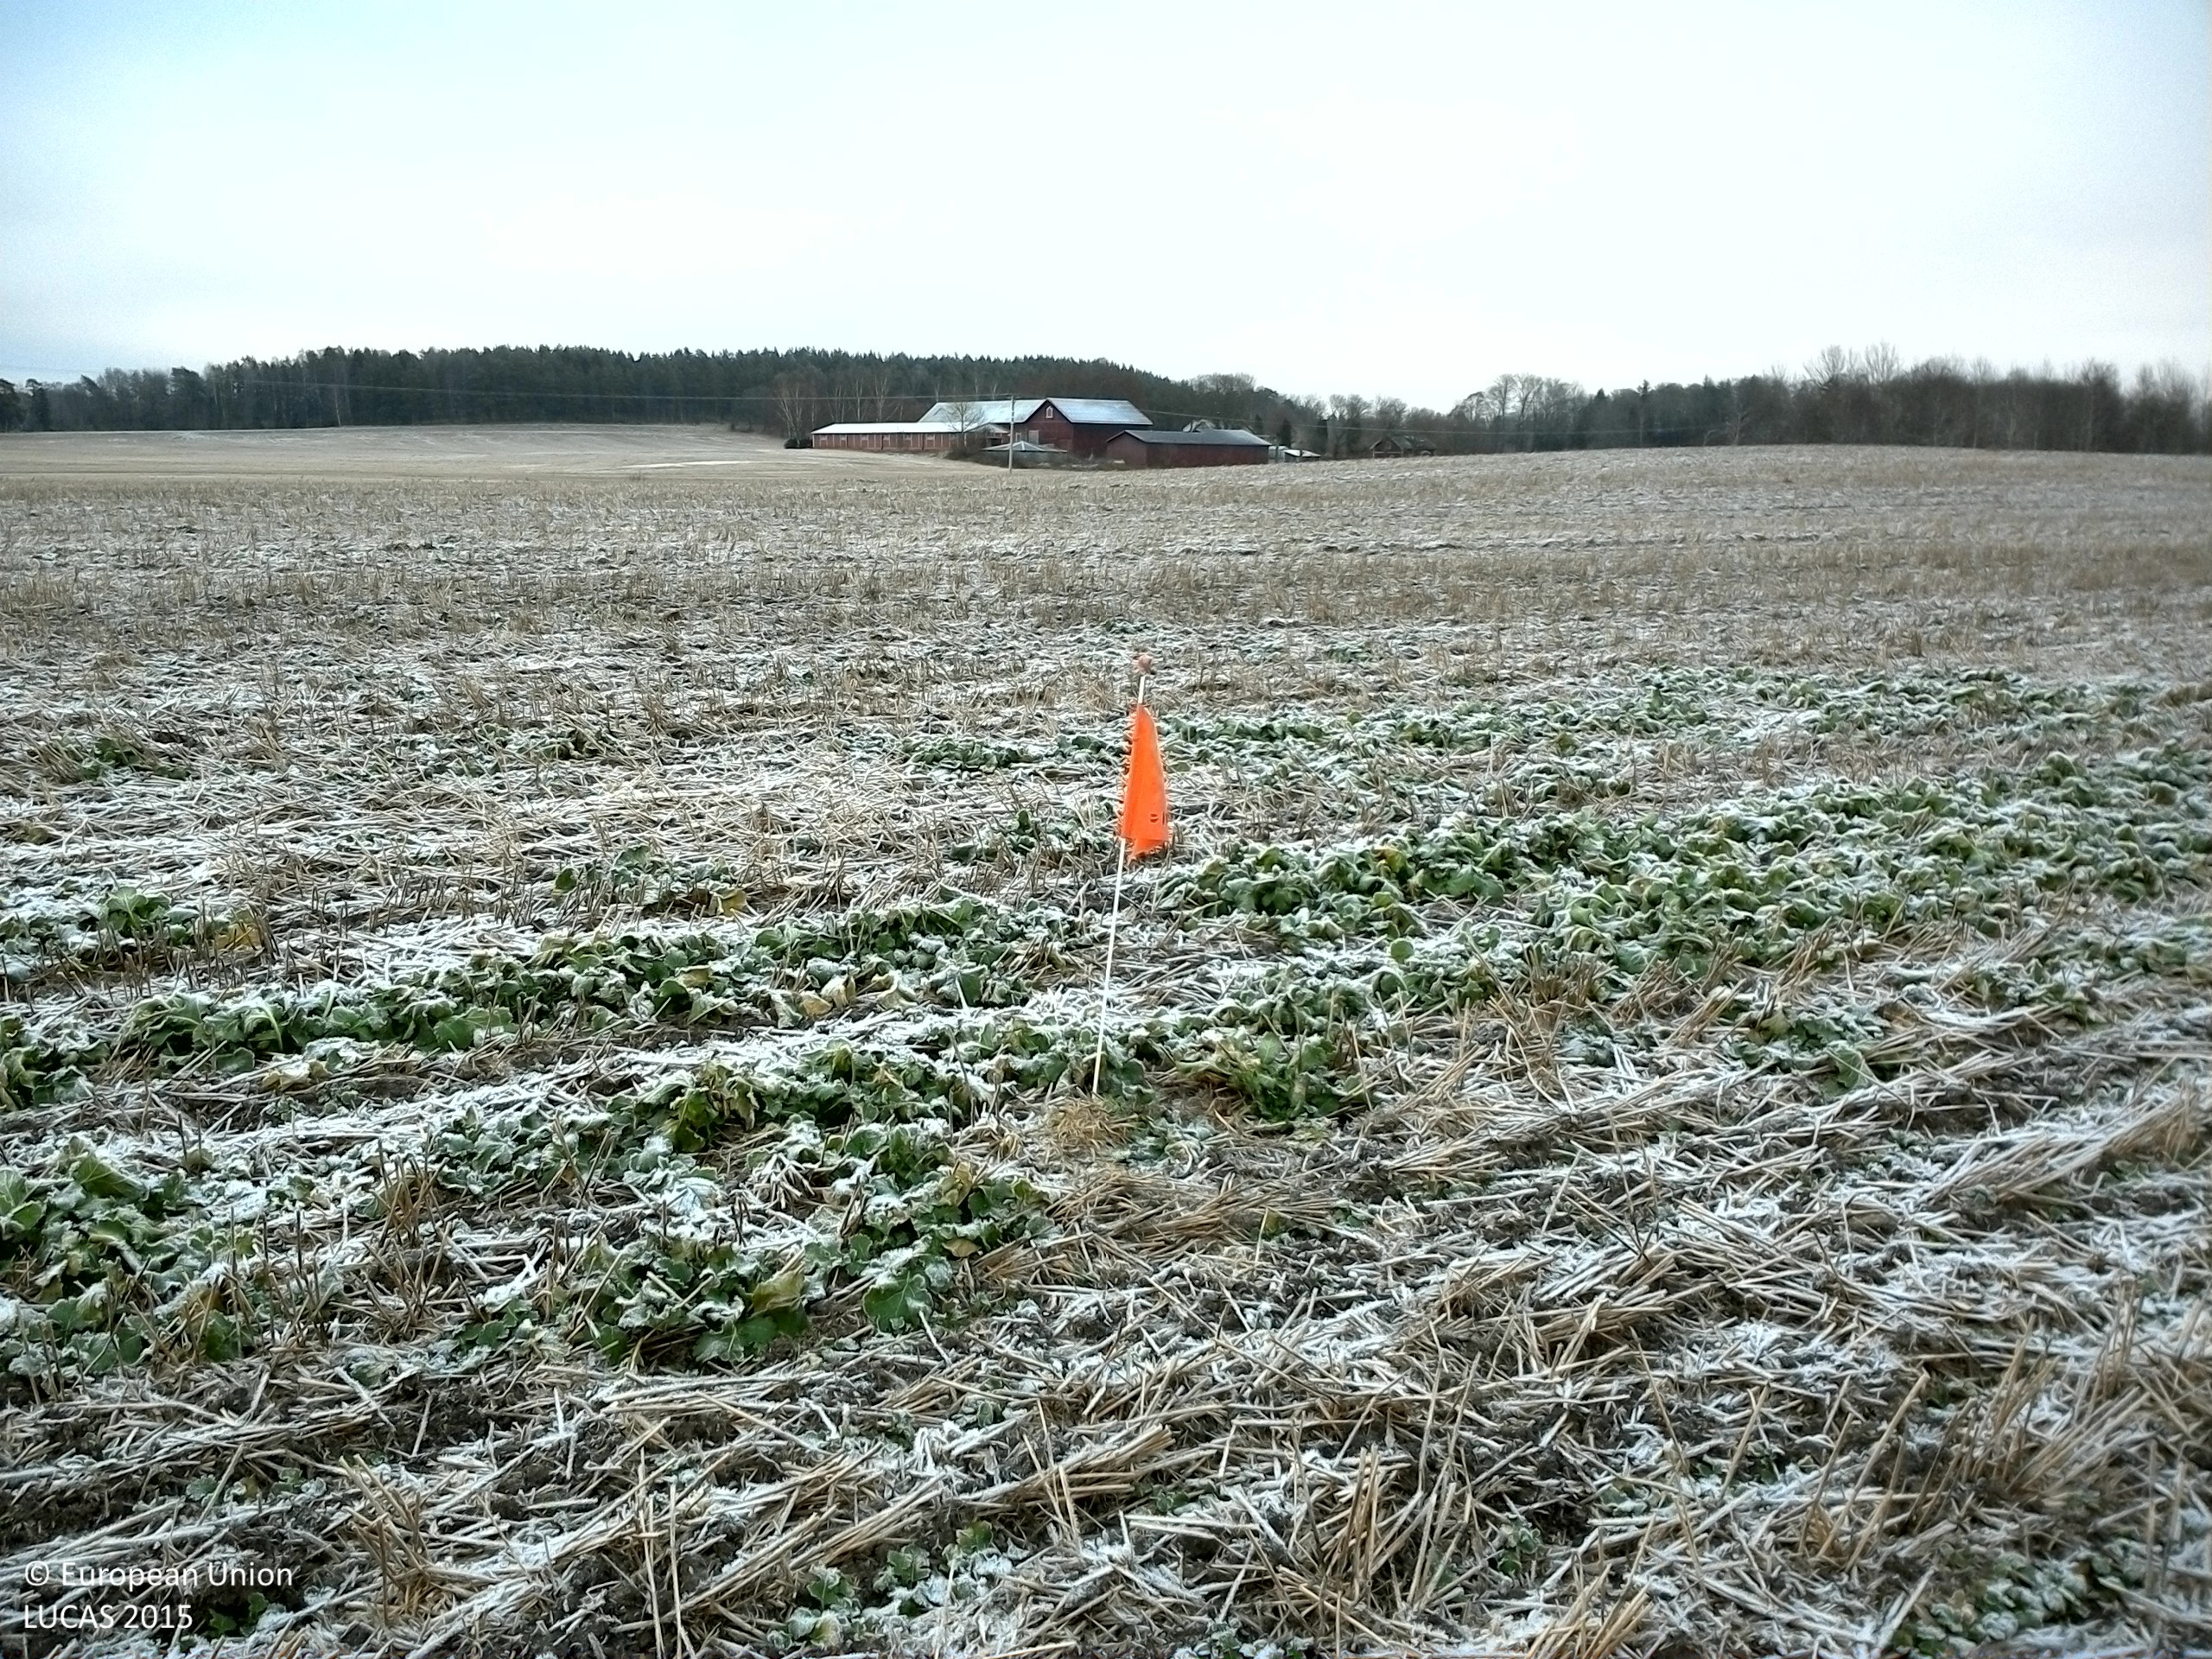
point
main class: Cropland
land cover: Other leguminous and mixtures for fodder
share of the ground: 50 - 75 %
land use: Agriculture (excluding fallow land and kitchen gardens)
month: December
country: SE
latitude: 59.4019
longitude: 17.1633
